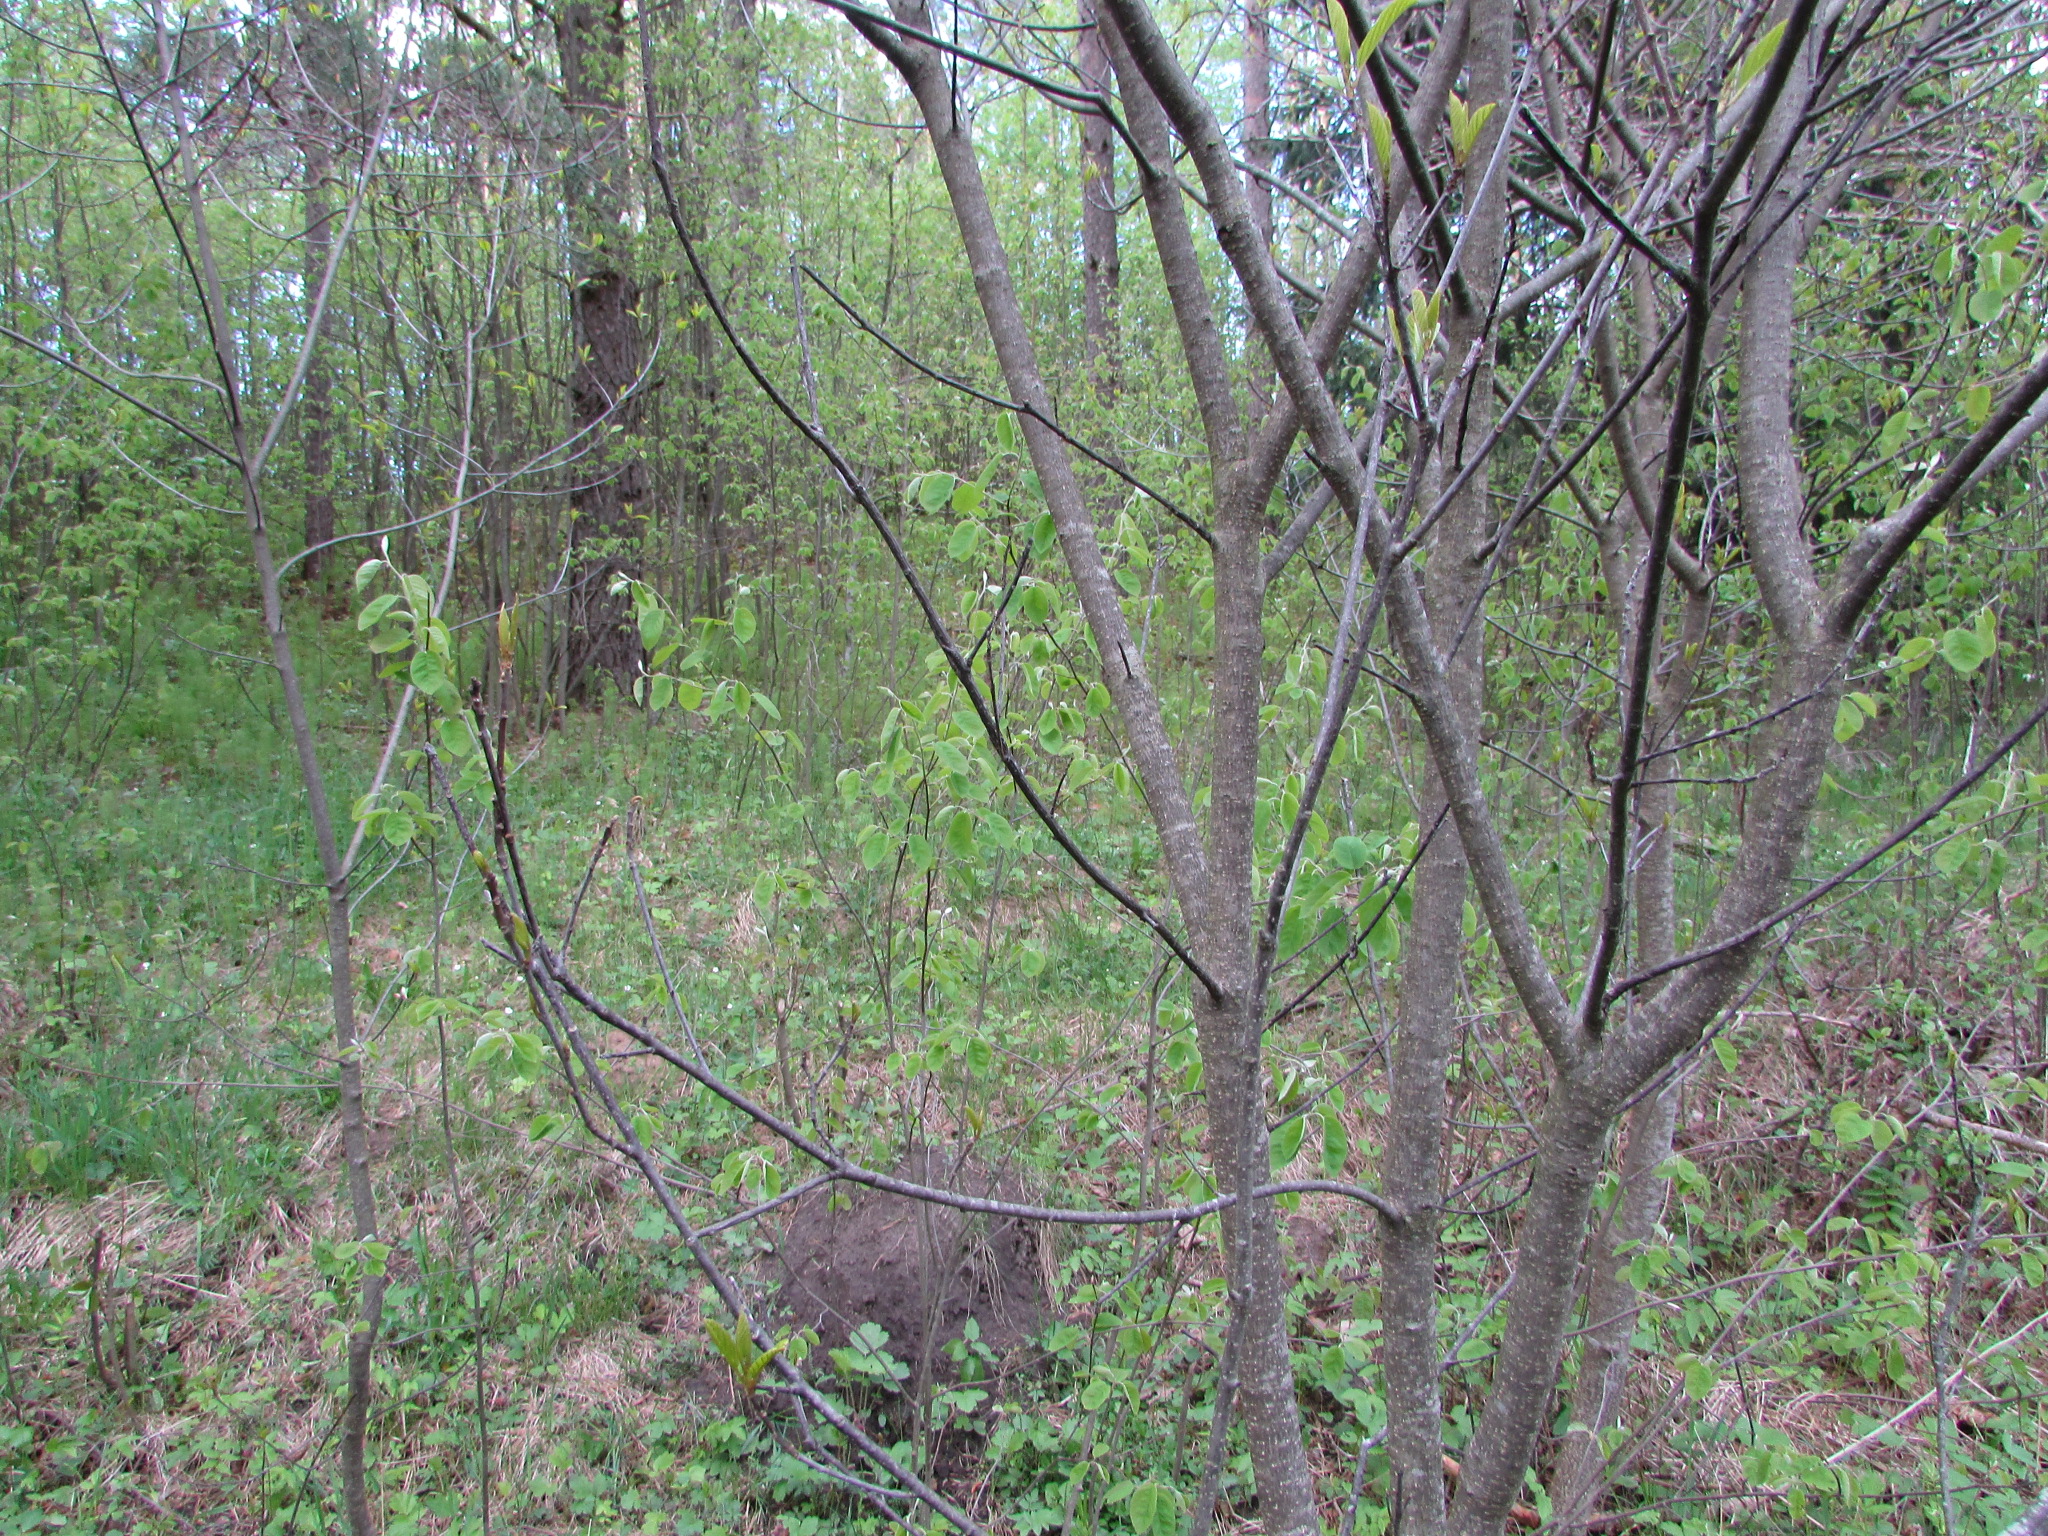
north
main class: Woodland
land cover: Pine dominated mixed woodland
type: hemiboreal forest and nemoral coniferous forest and mixed broadleaved-coniferous forest
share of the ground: > 75 %
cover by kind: coniferous forest trees 60 %, broadleaved forest trees 40 %
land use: Forestry
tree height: > 5 m
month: May
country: LV
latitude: 56.1402
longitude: 27.1809
